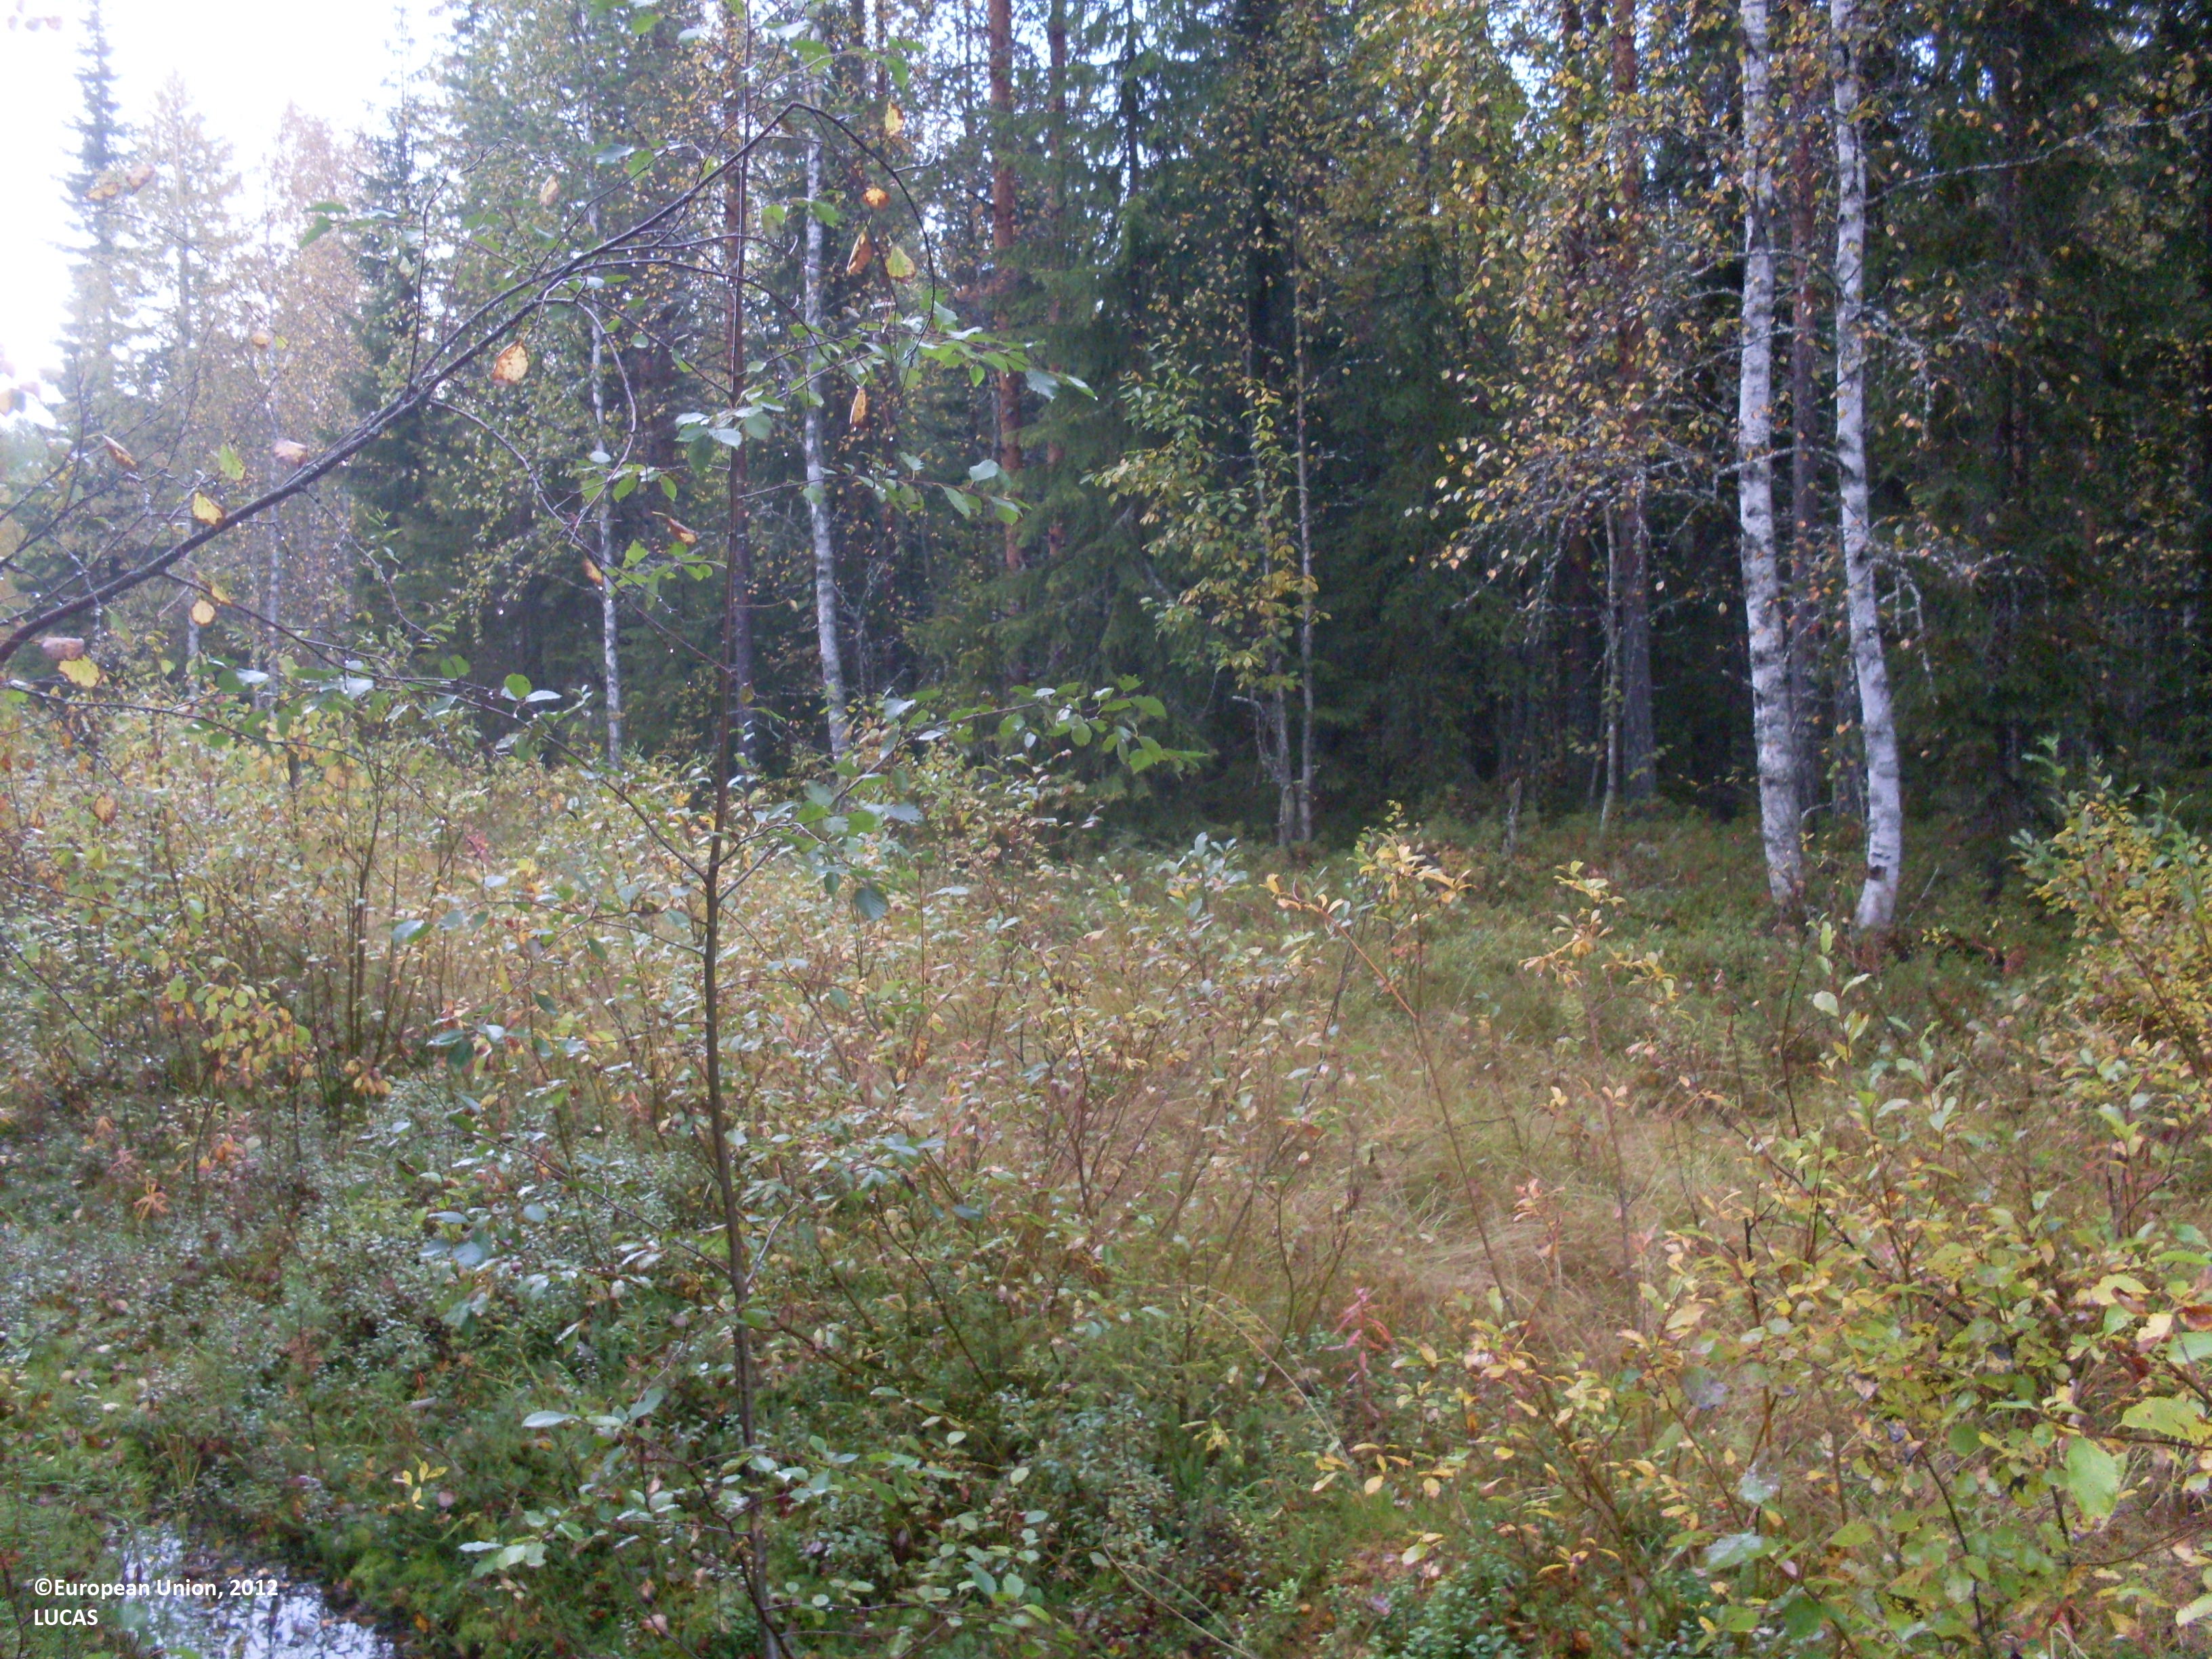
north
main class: Woodland
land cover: Other mixed woodland
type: boreal forest
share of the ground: > 75 %
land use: Forestry
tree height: > 5 m
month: September
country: FI
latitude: 64.0336
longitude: 29.9088
